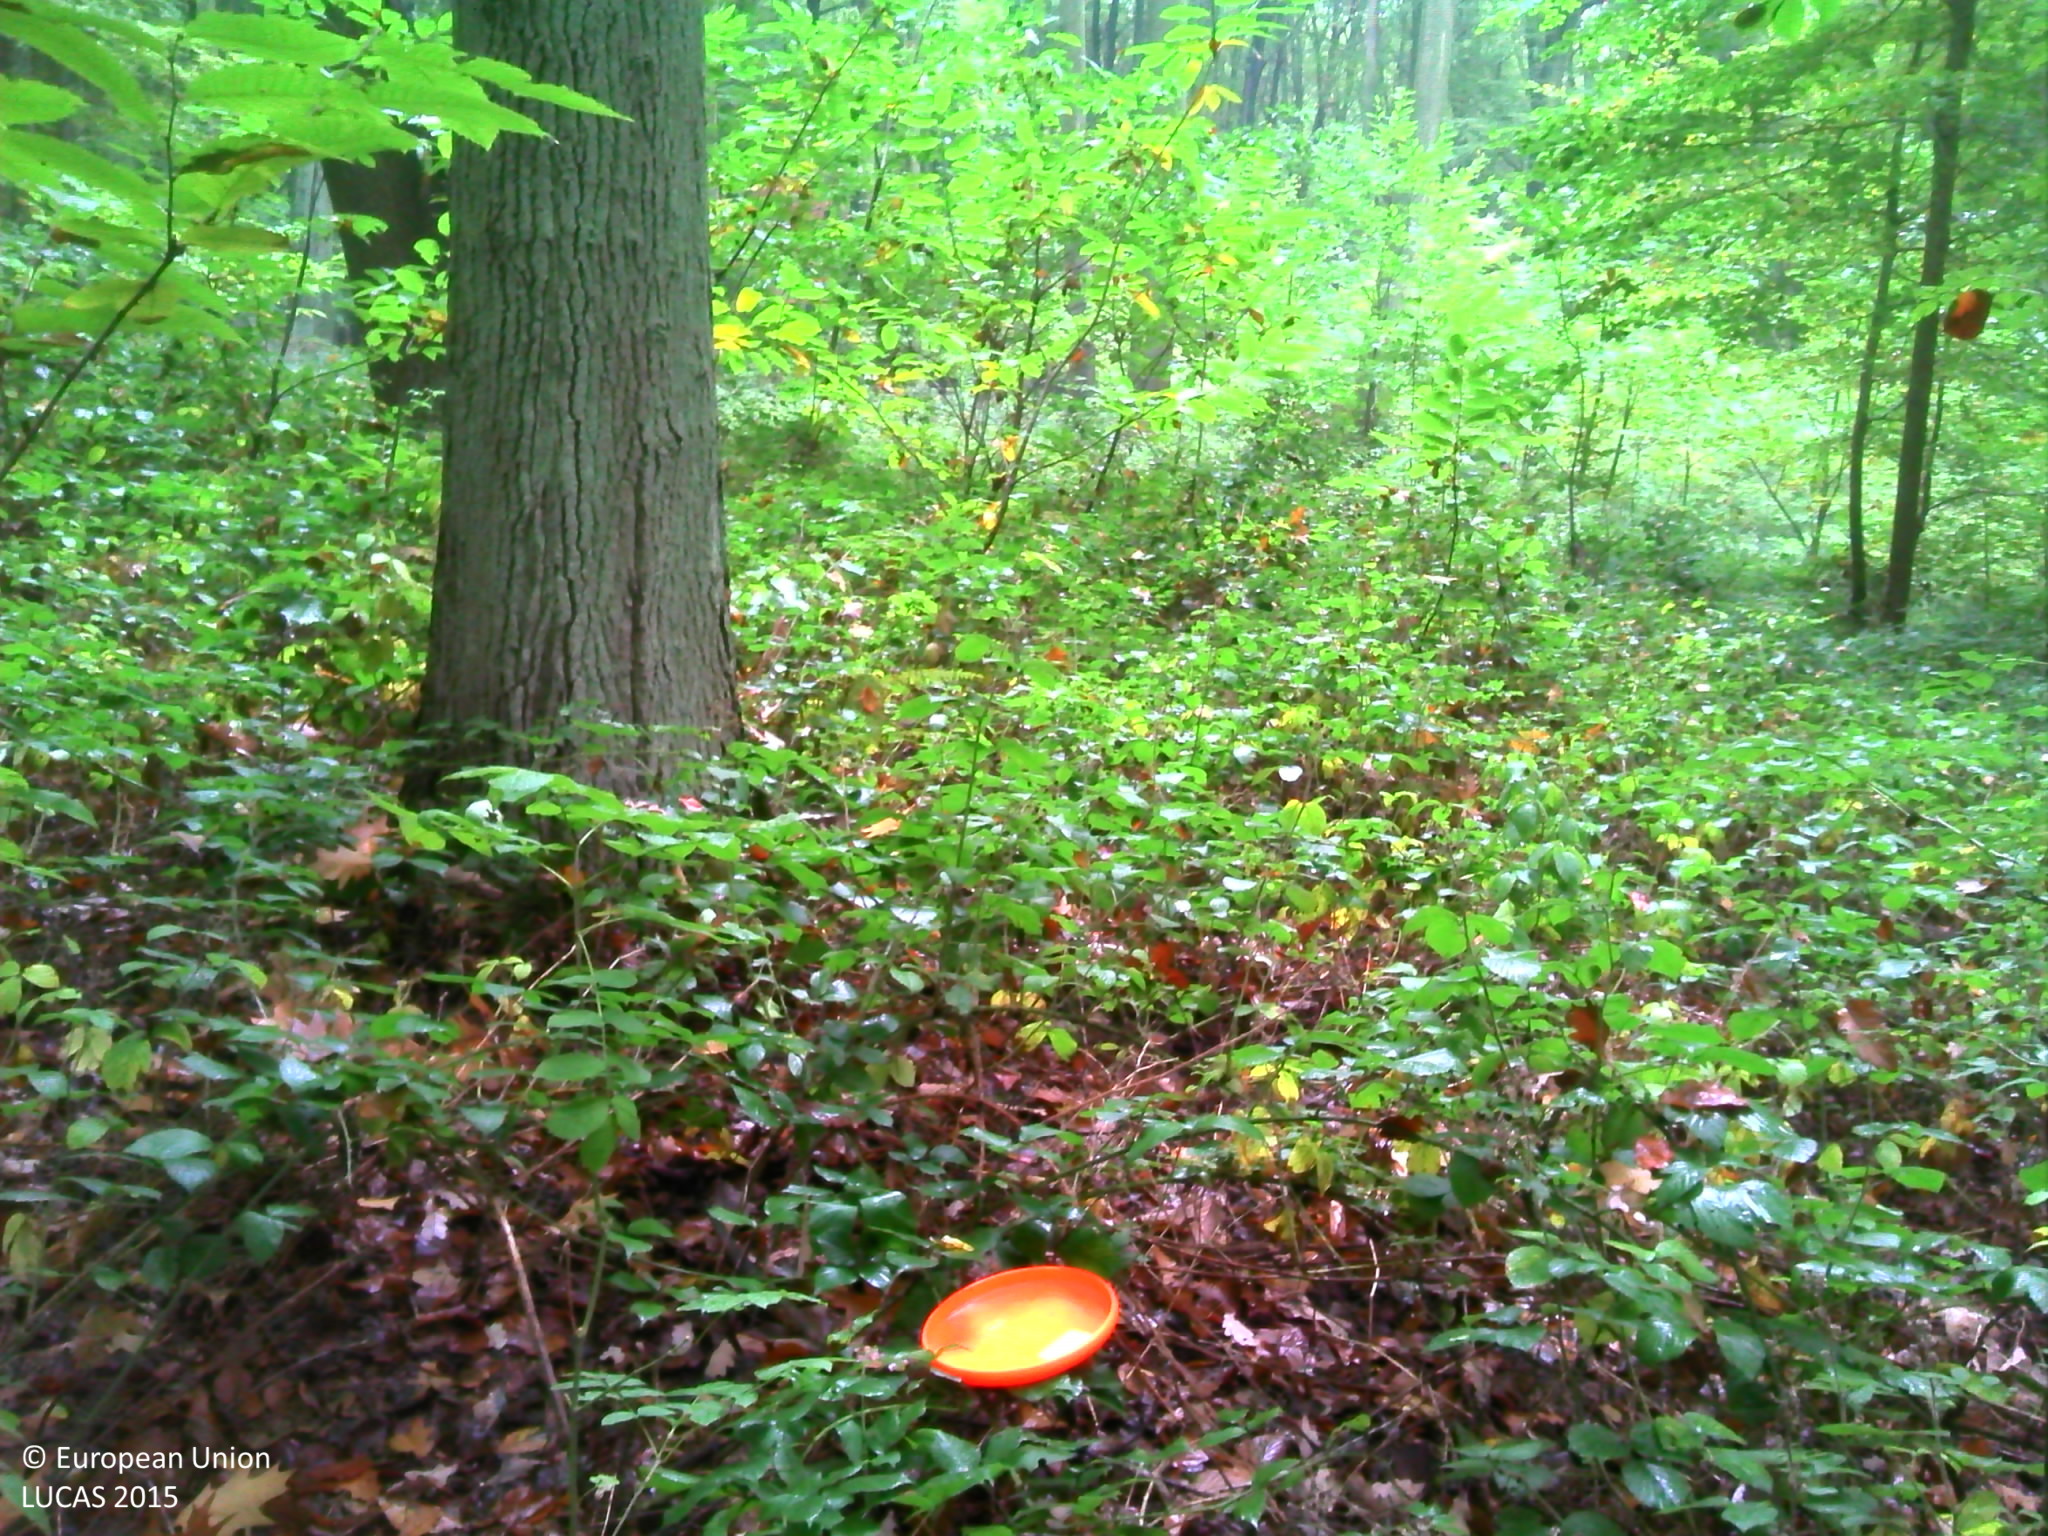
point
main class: Woodland
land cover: Broadleaved woodland
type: beech forest
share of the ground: > 75 %
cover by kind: broadleaved forest trees 80 %, shrubs 10 %, herbaceous plants 10 %
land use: Forestry
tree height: > 5 m
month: October
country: BE
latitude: 50.8651
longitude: 4.5541
